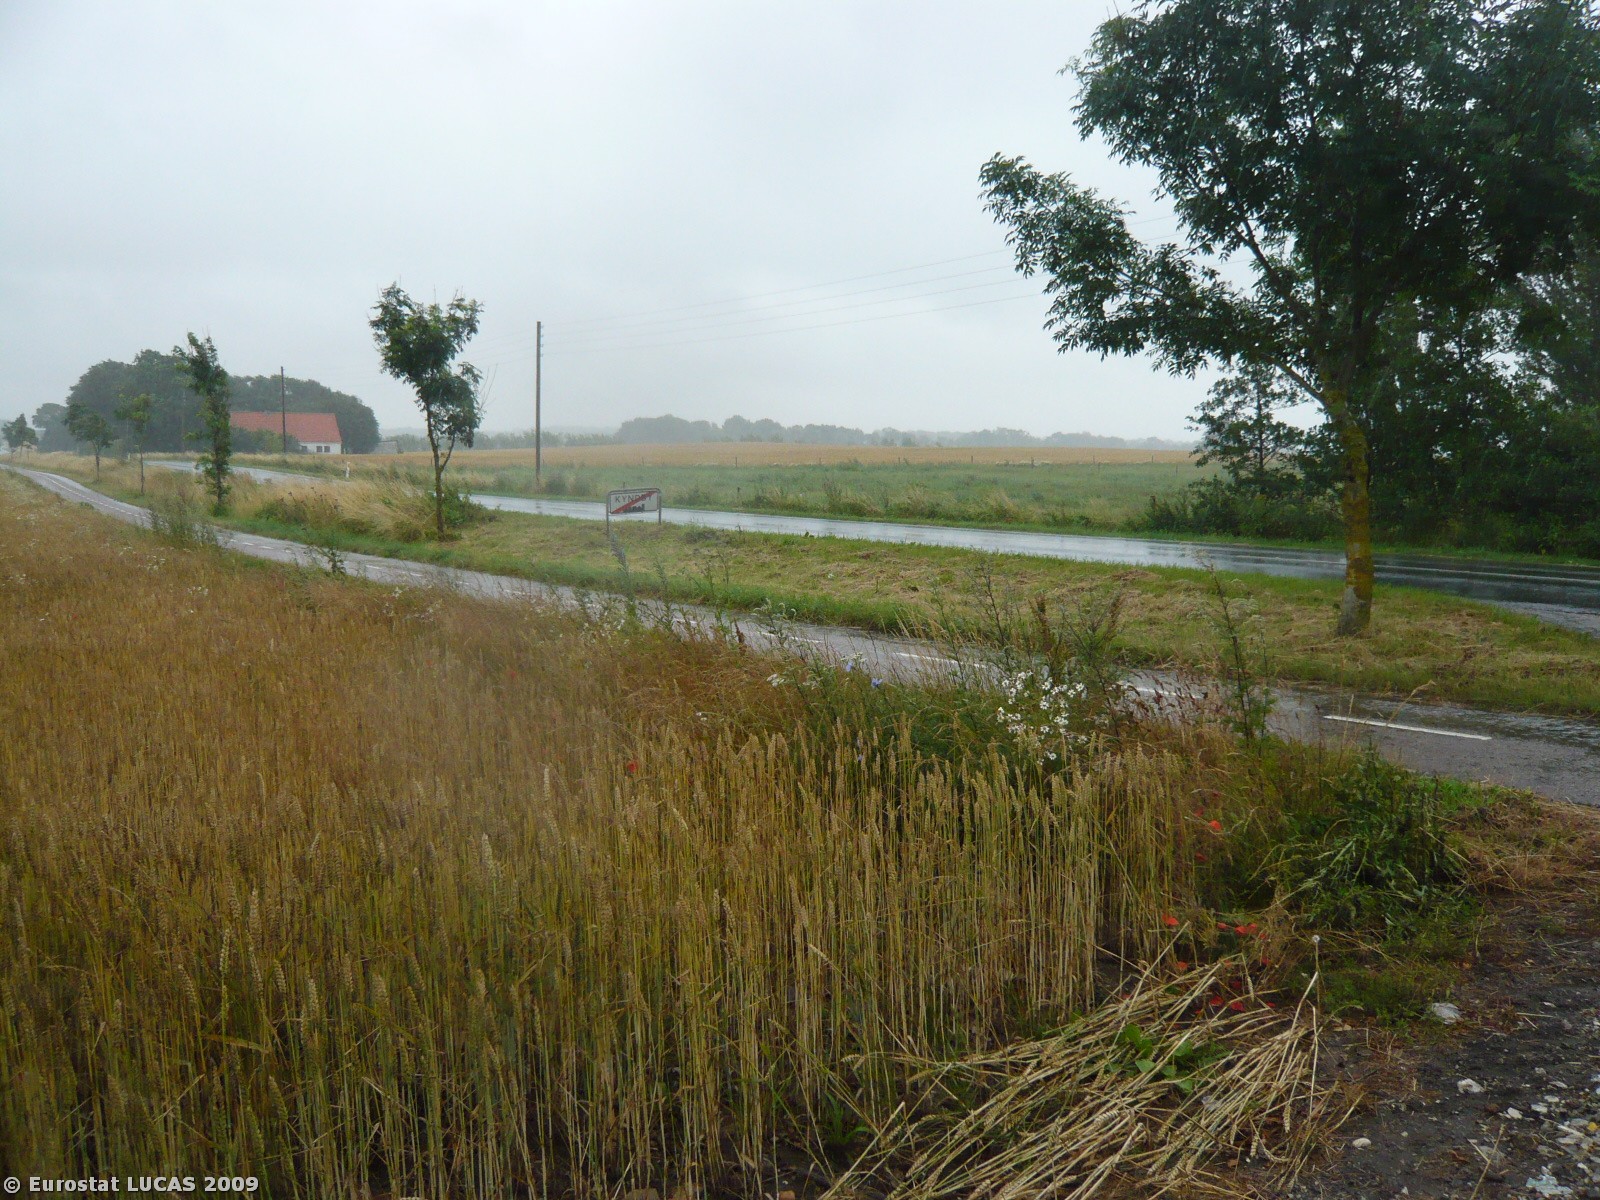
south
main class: Cropland
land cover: Common wheat
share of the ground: > 75 %
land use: Agriculture (excluding fallow land and kitchen gardens)
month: July
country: DK
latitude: 55.7957
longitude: 11.9282
